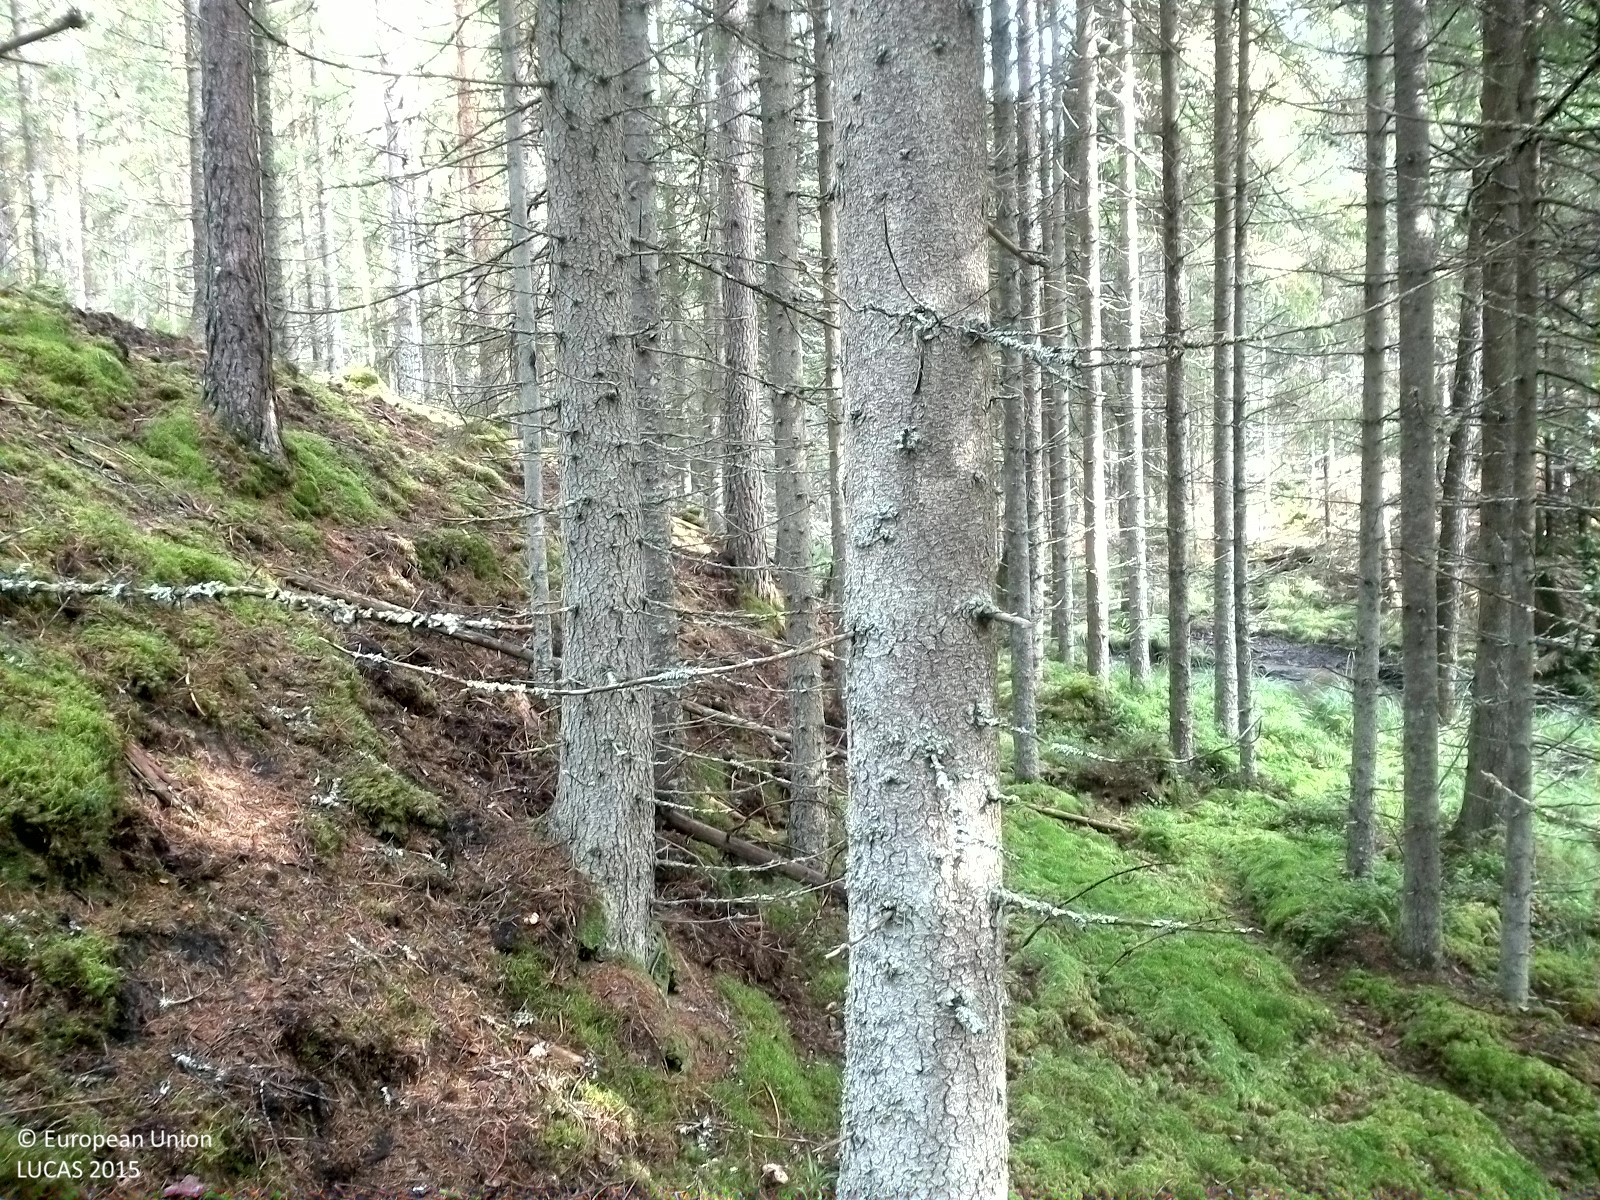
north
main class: Woodland
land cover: Spruce dominated coniferous woodland
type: boreal forest
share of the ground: 50 - 75 %
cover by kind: coniferous forest trees 55 %, lichens and mosses 30 %, unconsolidated bare surface 10 %, herbaceous plants 5 %
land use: Forestry
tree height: > 5 m
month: August
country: SE
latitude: 58.9546
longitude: 15.5037
